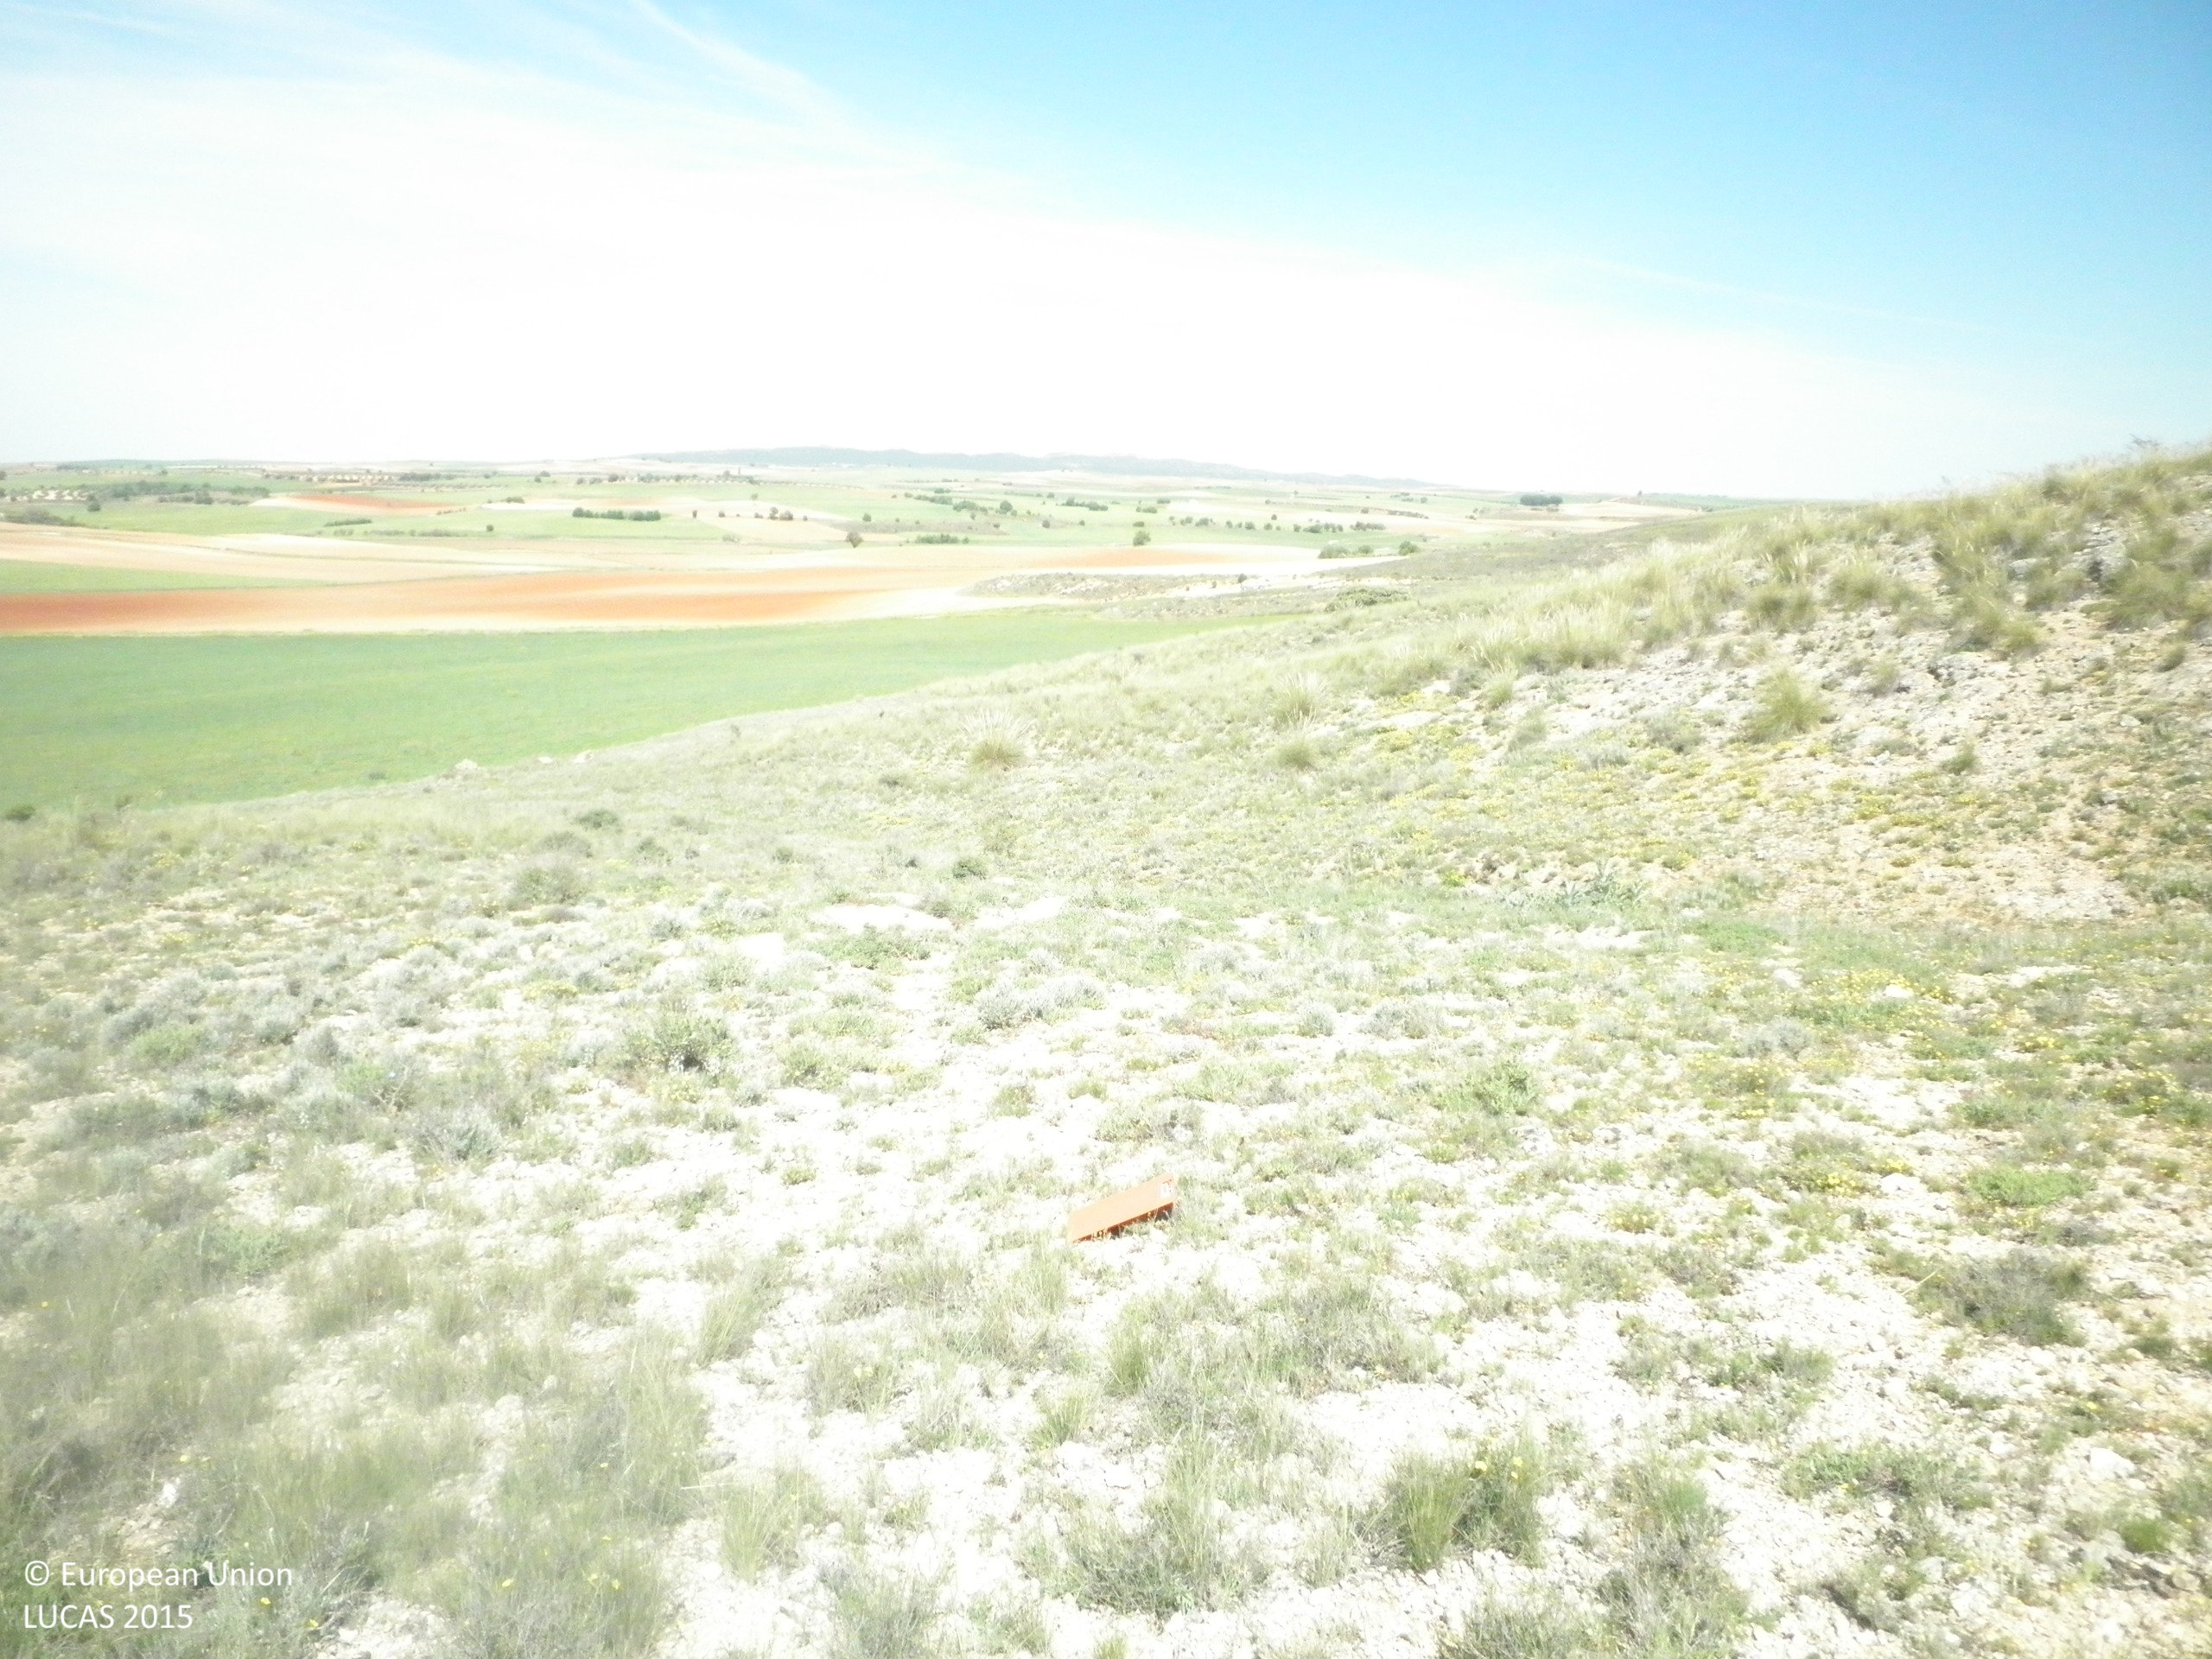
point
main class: Shrubland
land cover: Shrubland without tree cover
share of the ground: > 75 %
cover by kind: unconsolidated bare surface 50 %, herbaceous plants 25 %, shrubs 15 %, consolidated bare surface 10 %
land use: Semi-natural and natural areas not in use
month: May
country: ES
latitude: 39.7072
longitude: -2.7421
